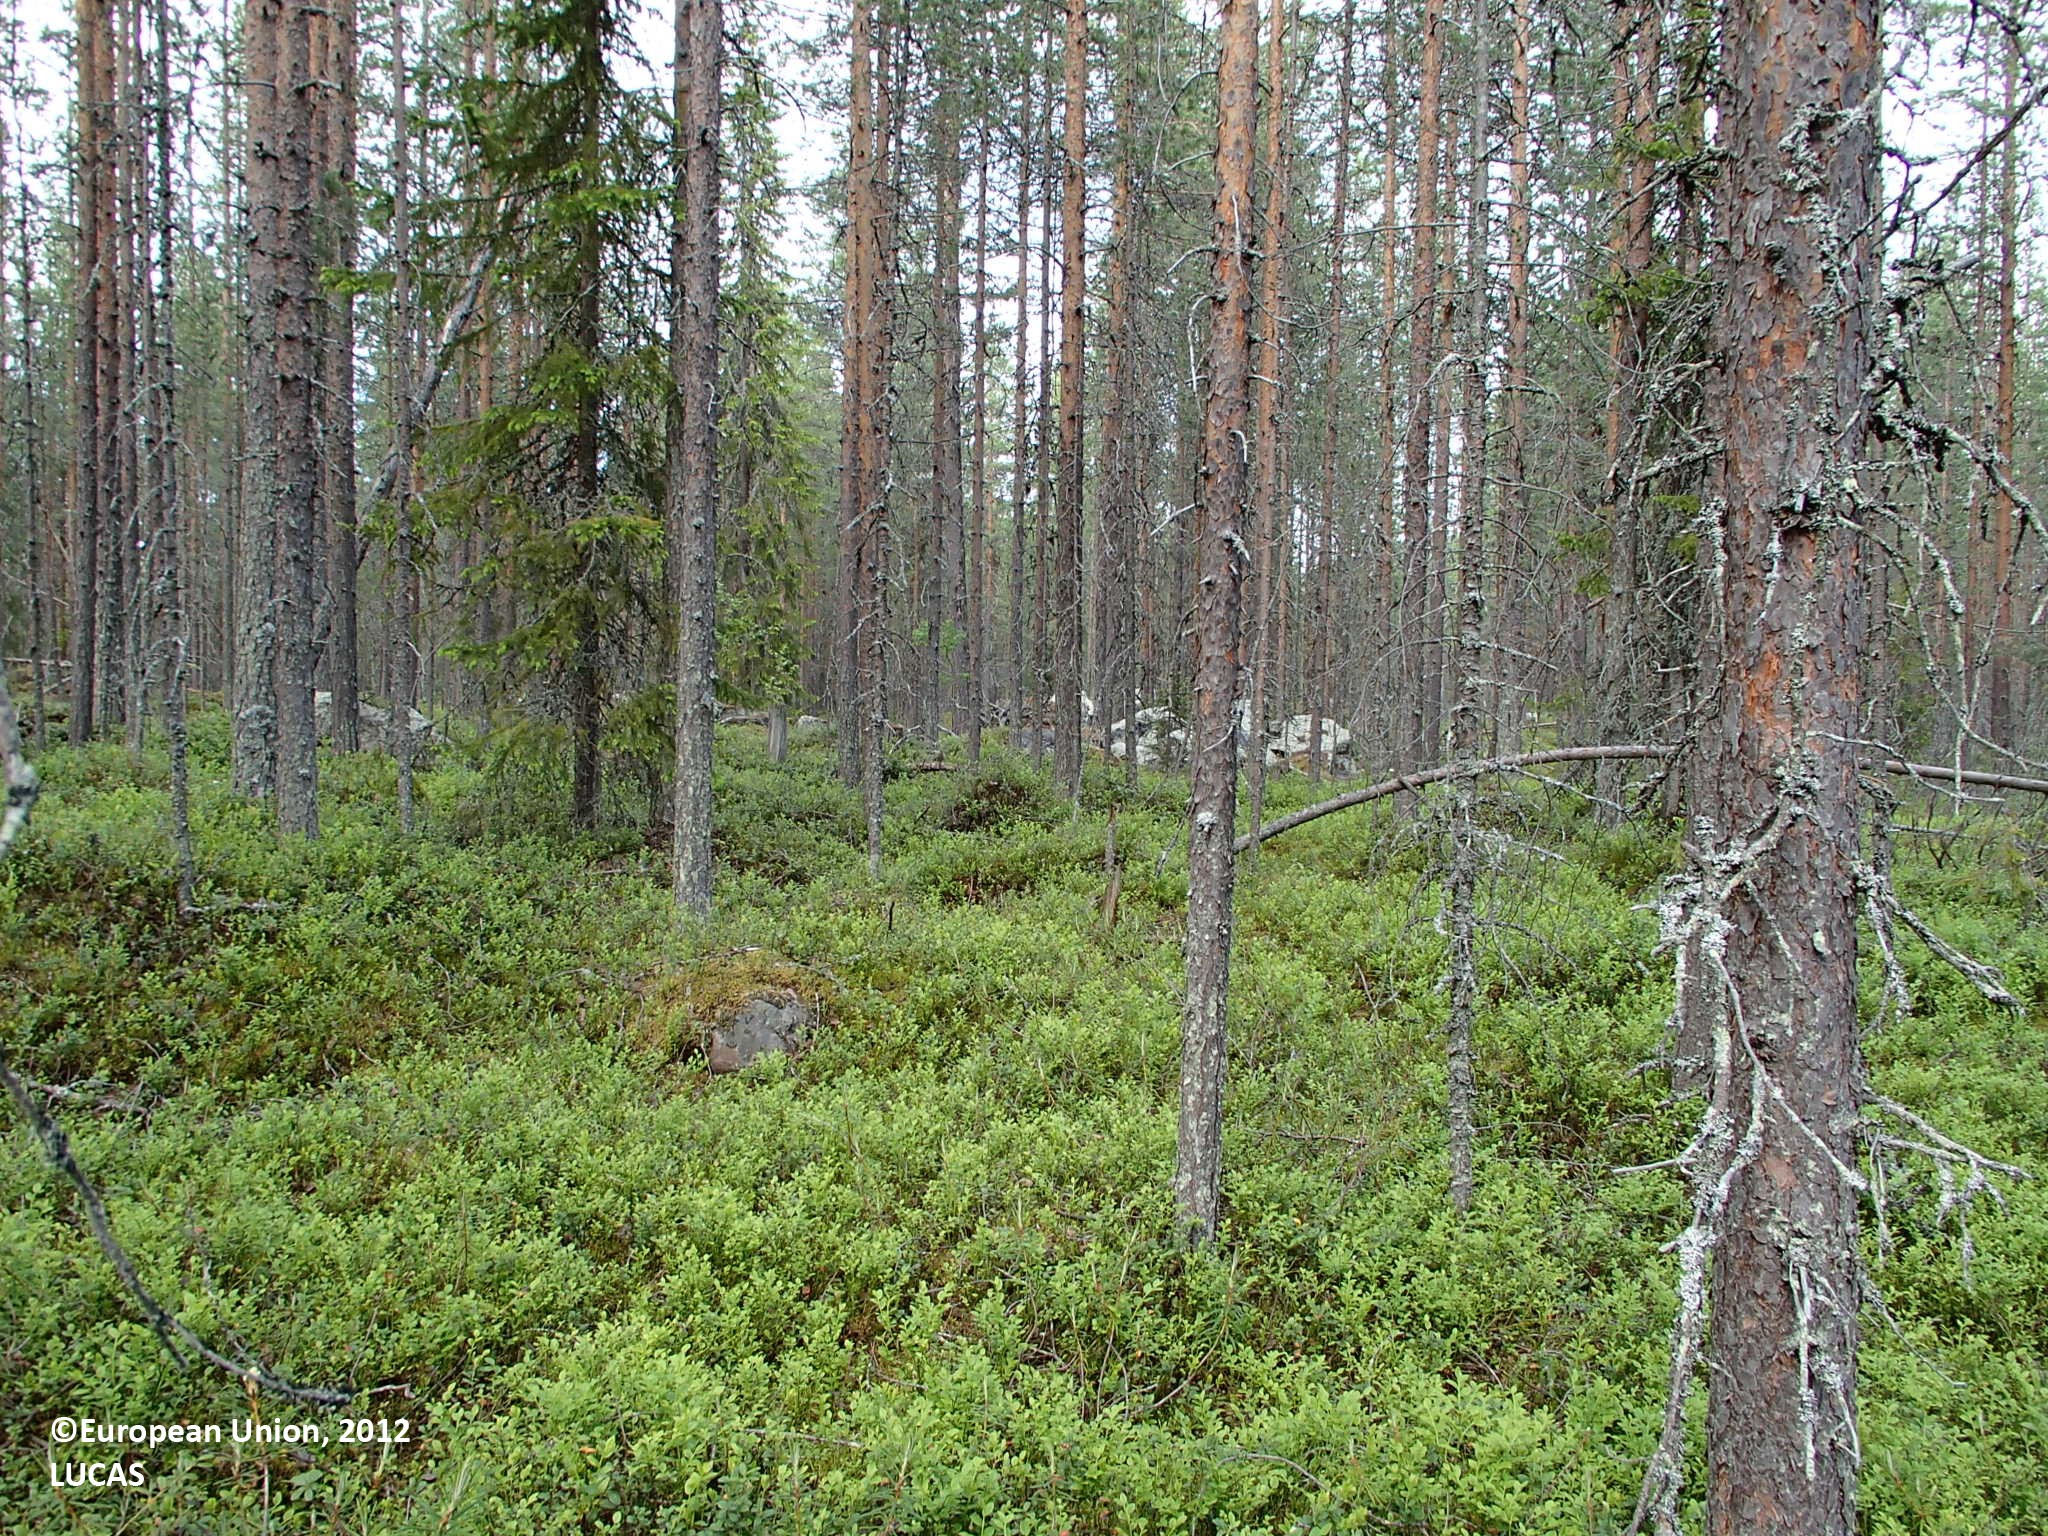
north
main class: Woodland
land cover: Pine dominated coniferous woodland
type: boreal forest
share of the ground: > 75 %
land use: Forestry
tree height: > 5 m
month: June
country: FI
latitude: 66.5785
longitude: 27.1701
